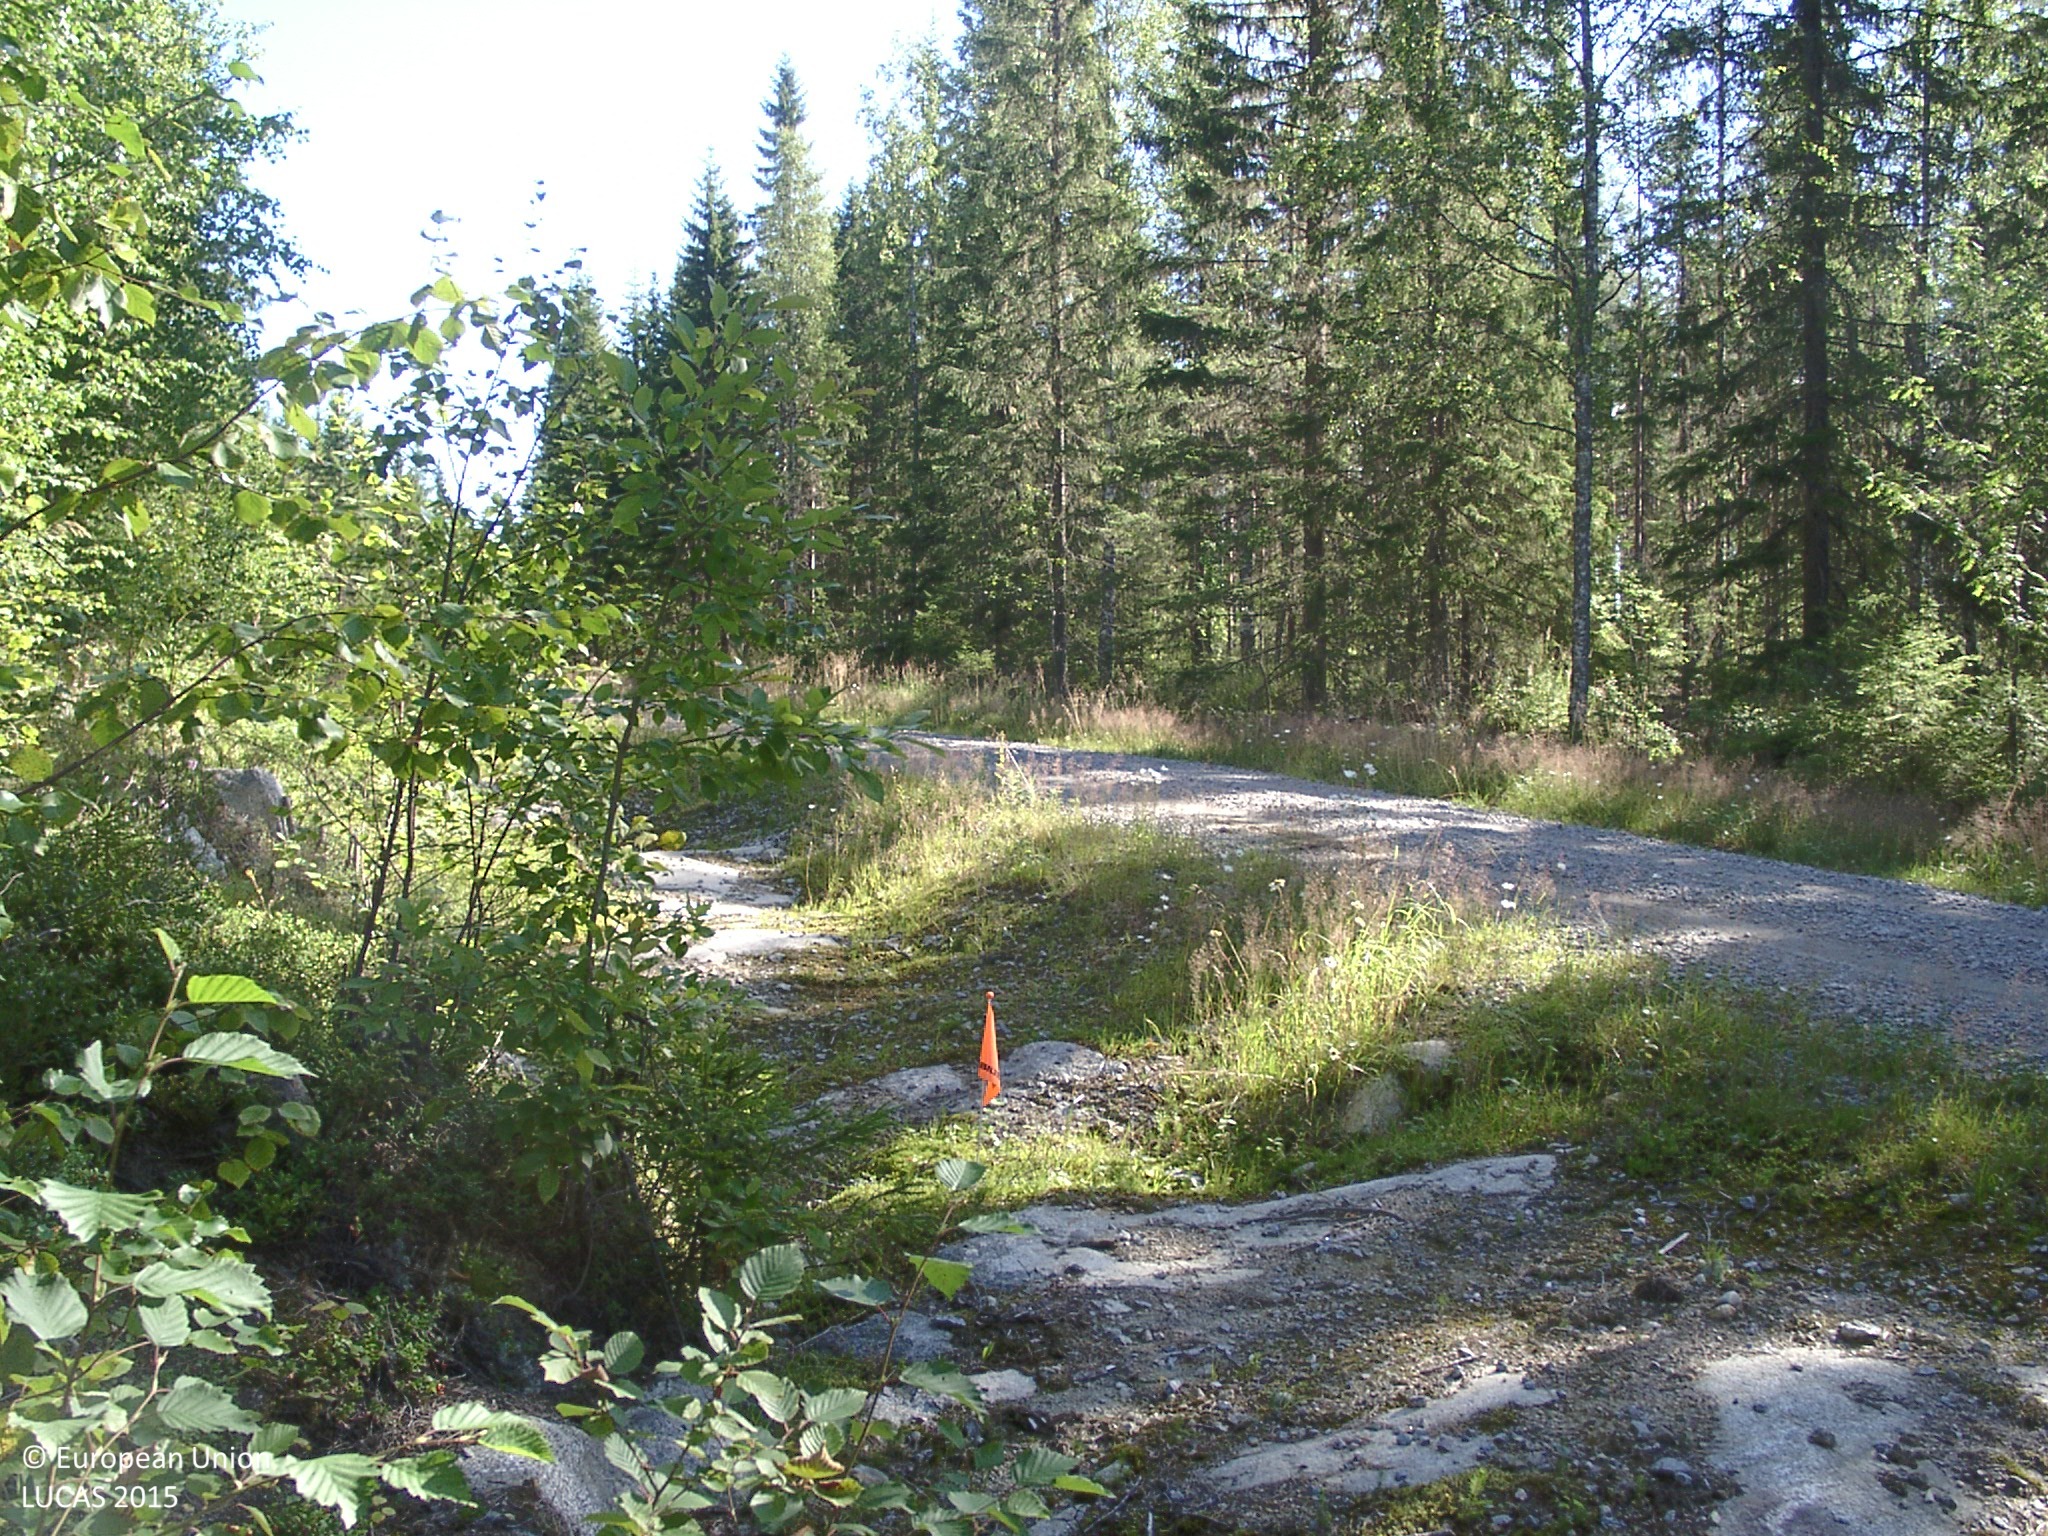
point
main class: Woodland
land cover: Other mixed woodland
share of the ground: 50 - 75 %
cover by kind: coniferous forest trees 45 %, shrubs 25 %, broadleaved forest trees 20 %, herbaceous plants 10 %
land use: Forestry
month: August
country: FI
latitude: 62.3683
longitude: 25.2008
